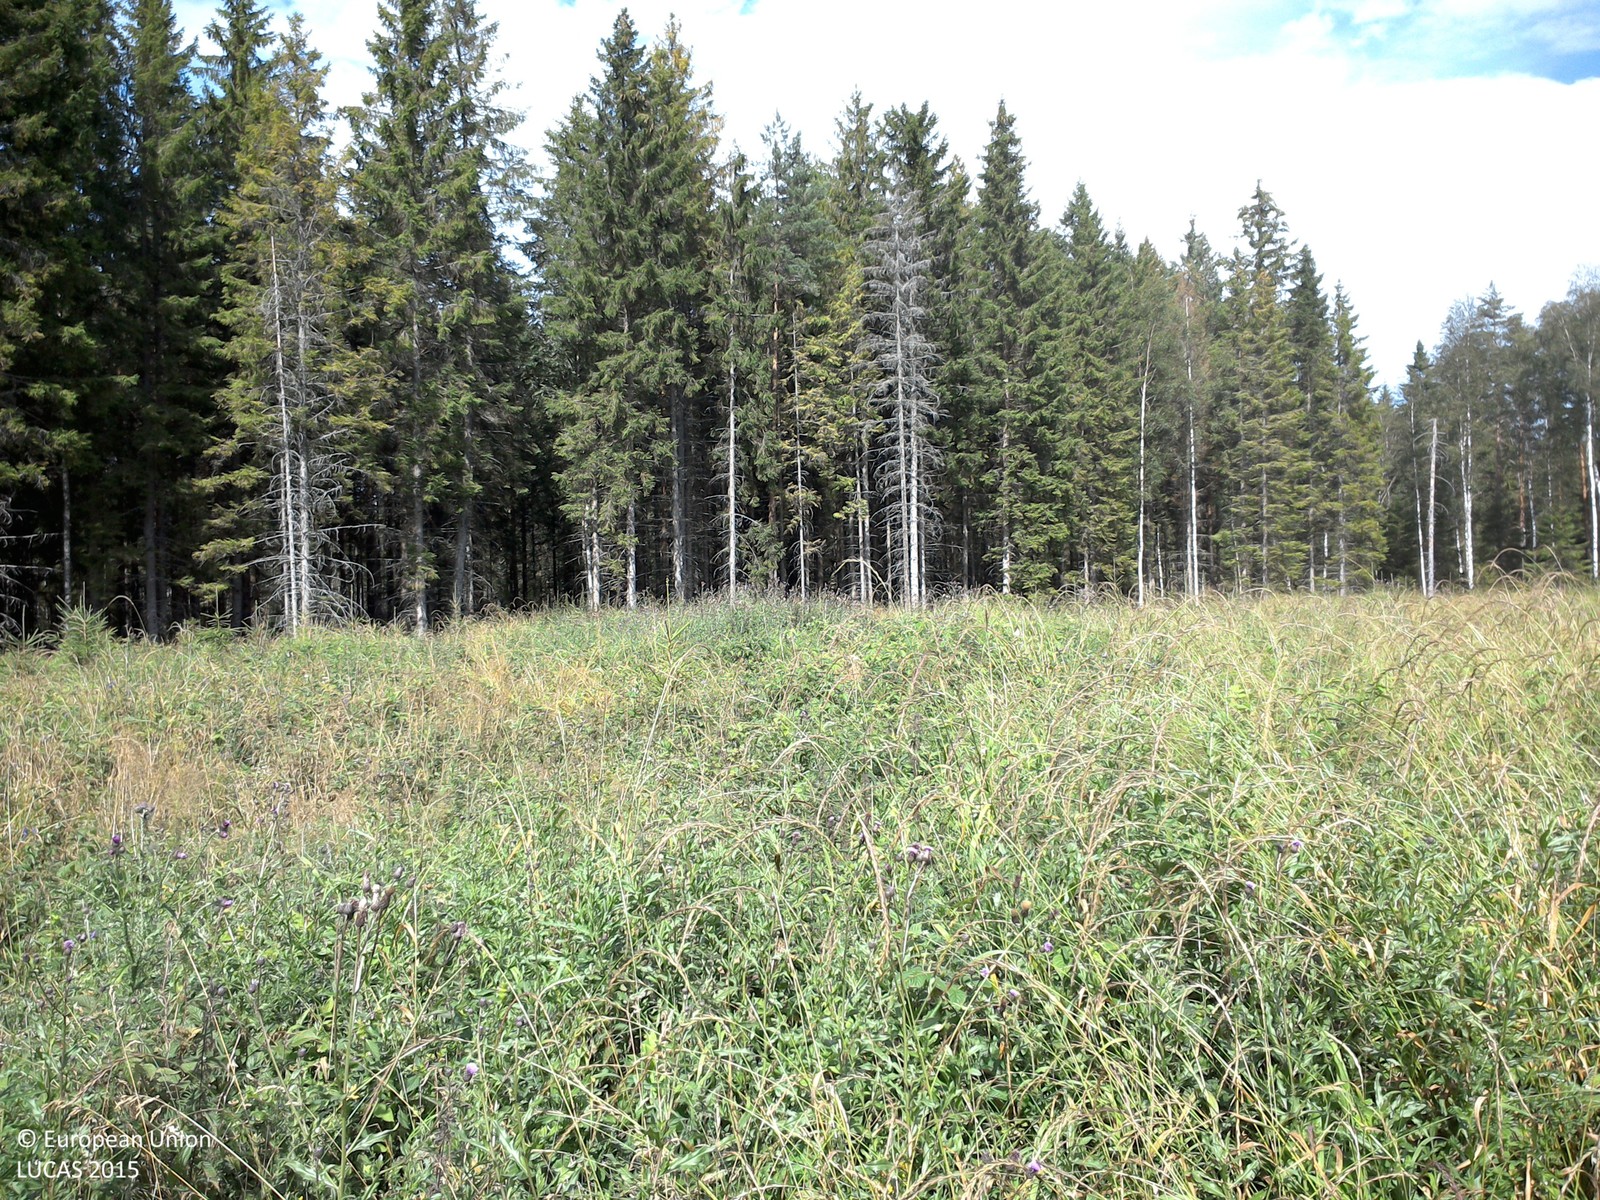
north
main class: Shrubland
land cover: Shrubland without tree cover
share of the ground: > 75 %
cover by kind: shrubs 90 %, herbaceous plants 10 %
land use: Forestry
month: August
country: SE
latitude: 58.1660
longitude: 14.9069
